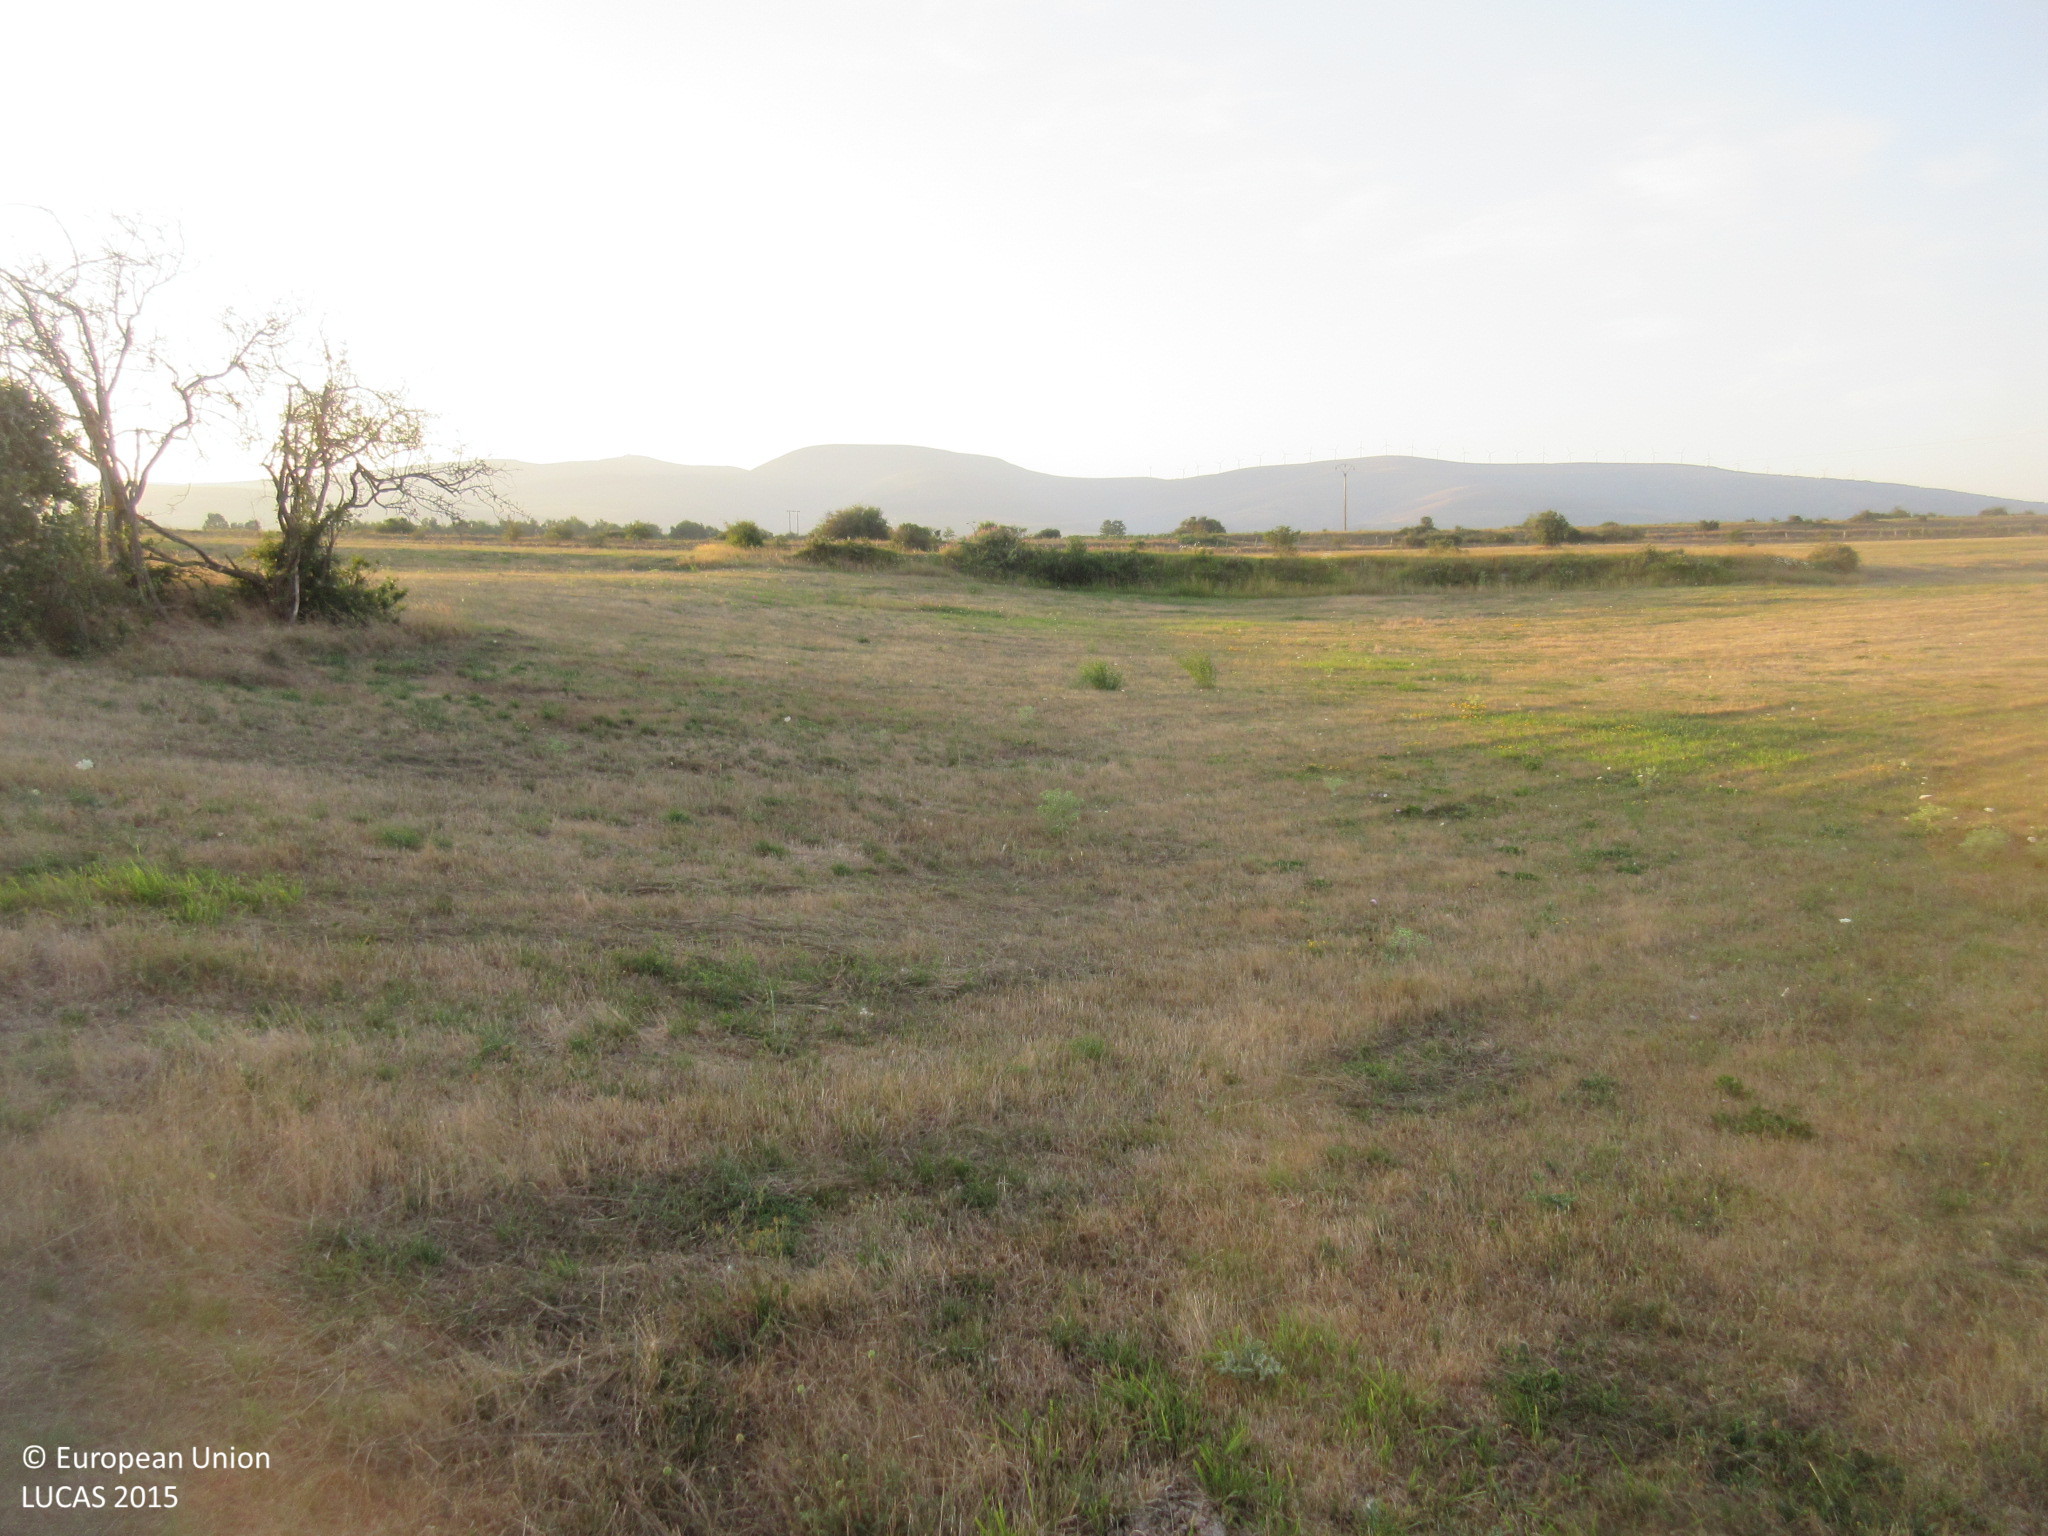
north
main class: Grassland
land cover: Grassland without tree/shrub cover
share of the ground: > 75 %
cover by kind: herbaceous plants 100 %
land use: Agriculture (excluding fallow land and kitchen gardens)
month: July
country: ES
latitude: 43.0604
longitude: -3.5104
